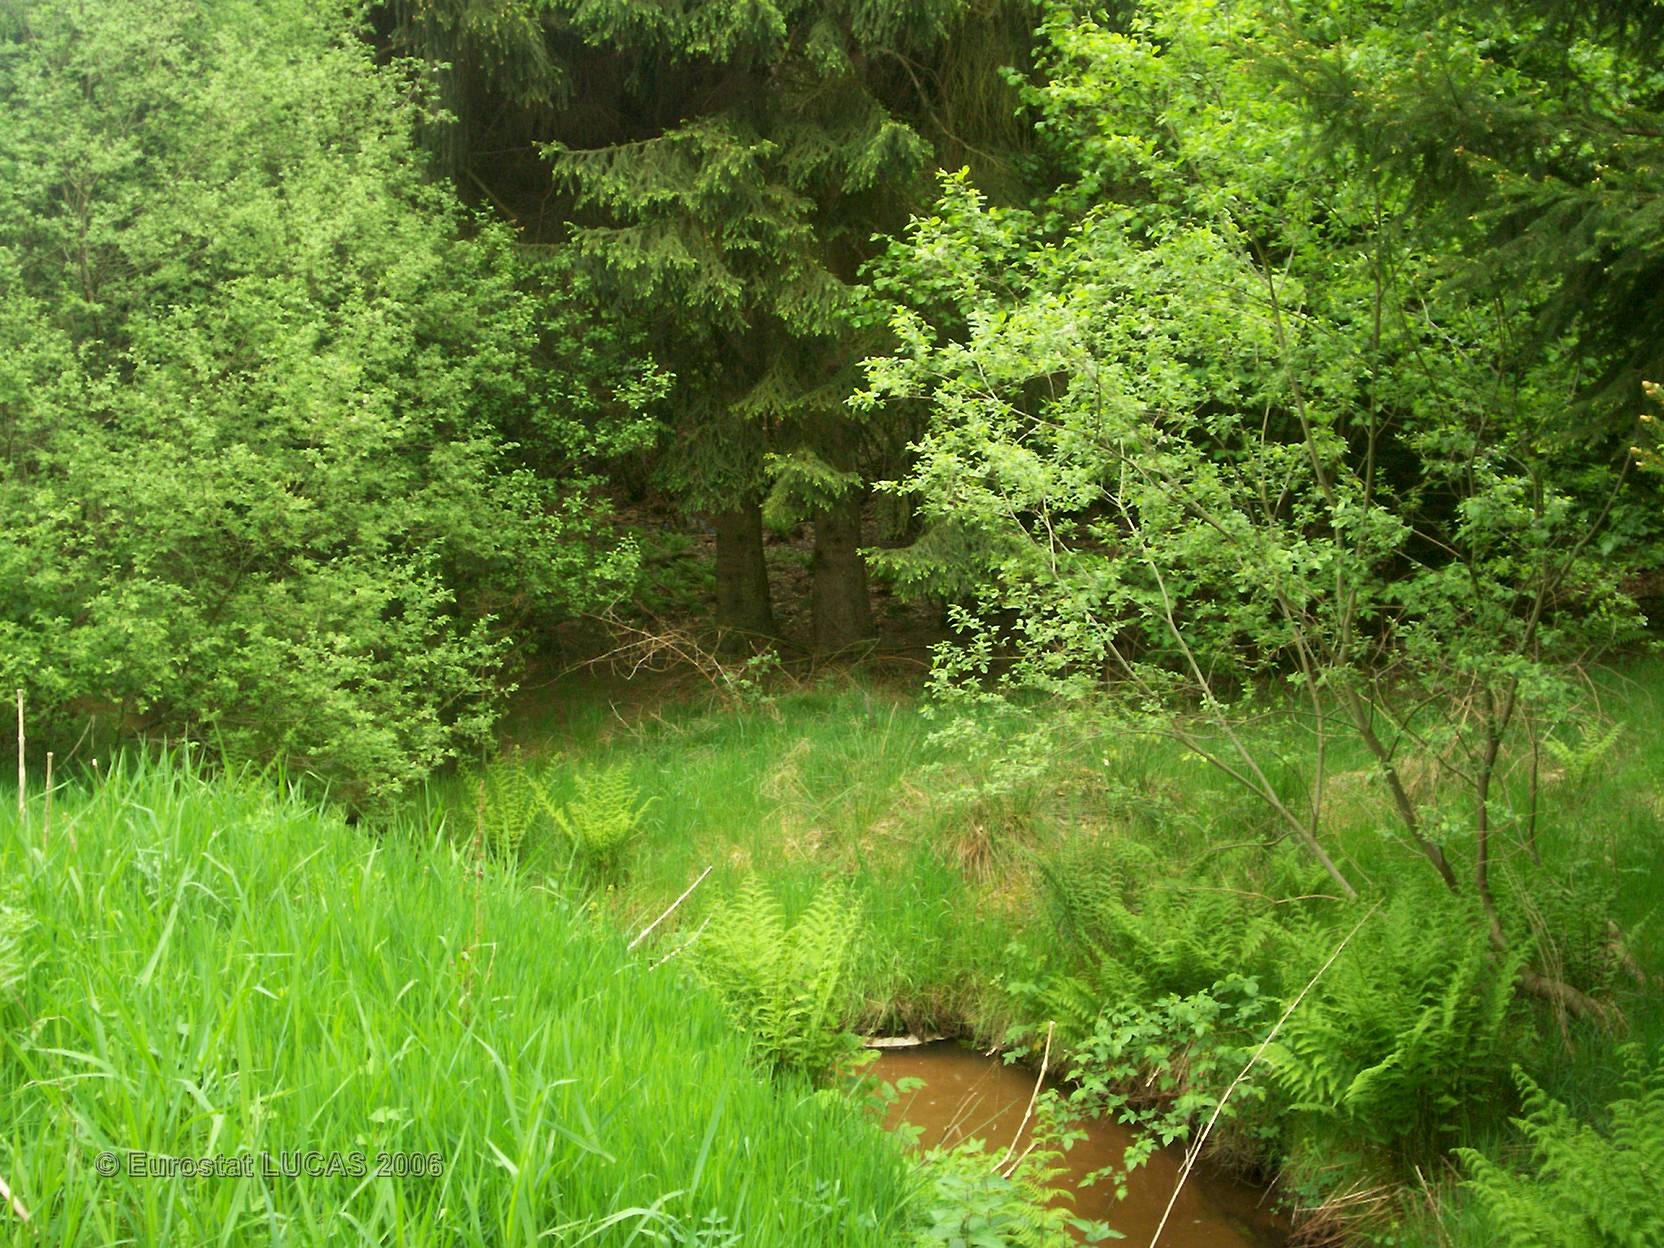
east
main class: Grassland
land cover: Grassland with sparse tree/shrub cover
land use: Unused
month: May
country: FR
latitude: 48.9122
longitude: 7.3672
